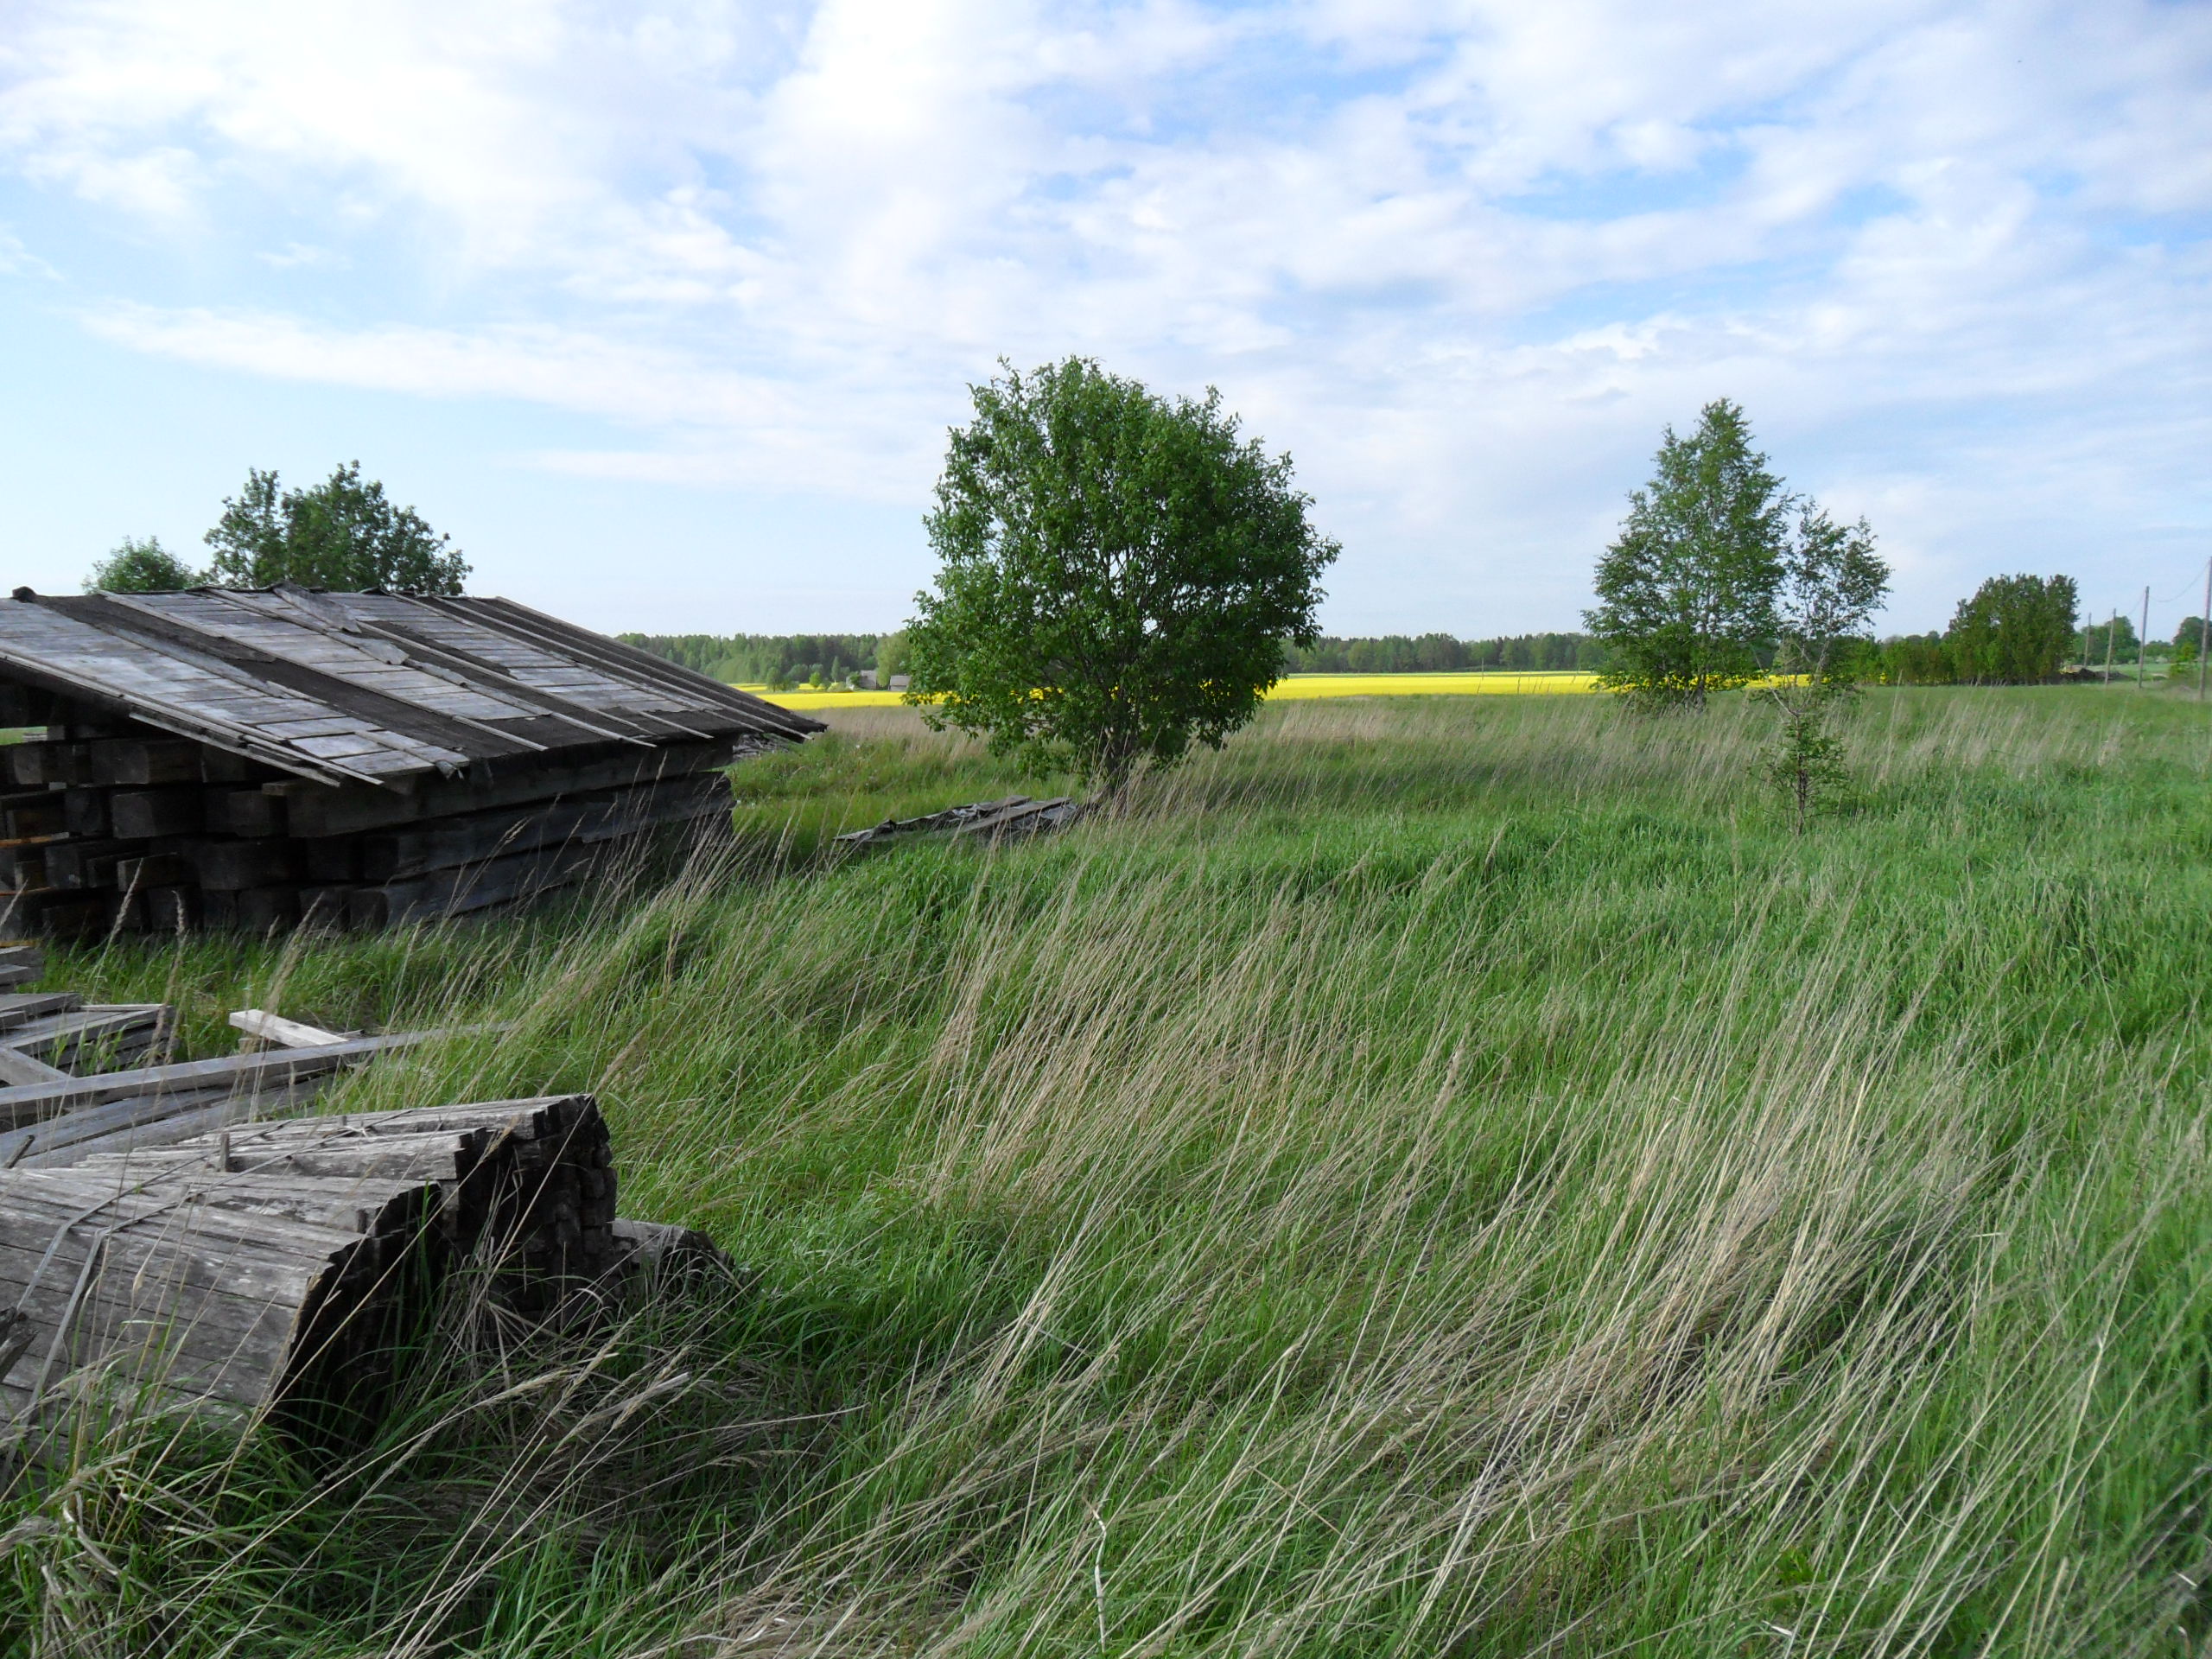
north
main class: Grassland
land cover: Grassland without tree/shrub cover
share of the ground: > 75 %
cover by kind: herbaceous plants 75 %
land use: Abandoned areas
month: June
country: LV
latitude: 57.3799
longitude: 22.4775
